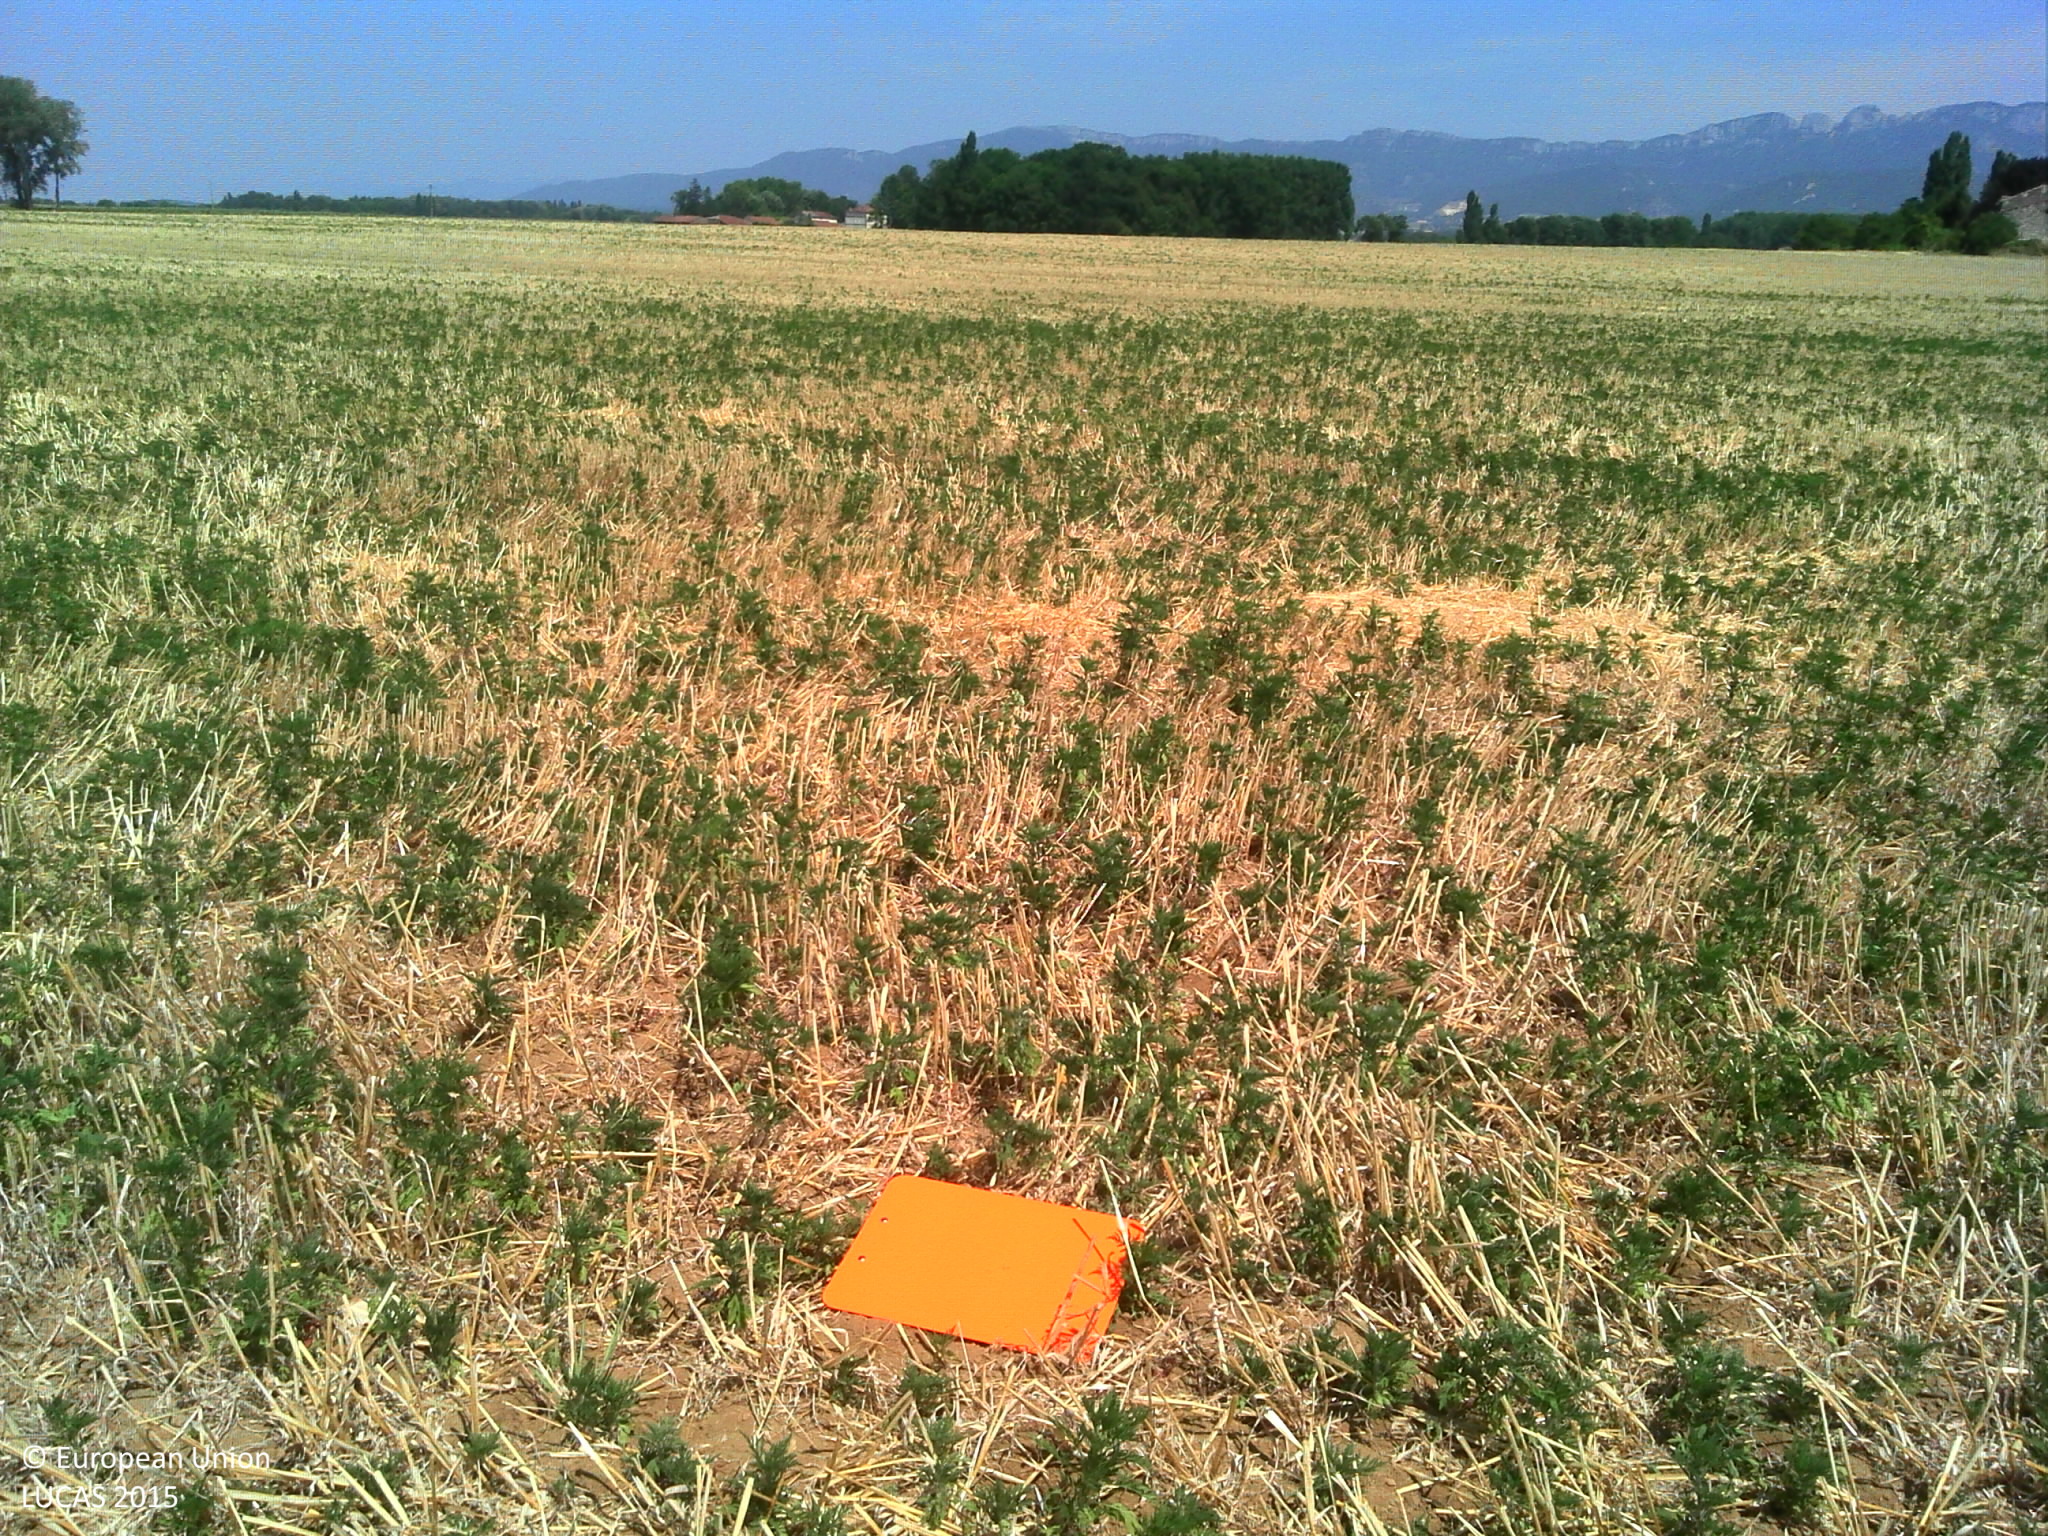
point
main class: Cropland
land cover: Barley
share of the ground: > 75 %
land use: Agriculture (excluding fallow land and kitchen gardens)
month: July
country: FR
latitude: 44.9538
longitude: 5.0242
